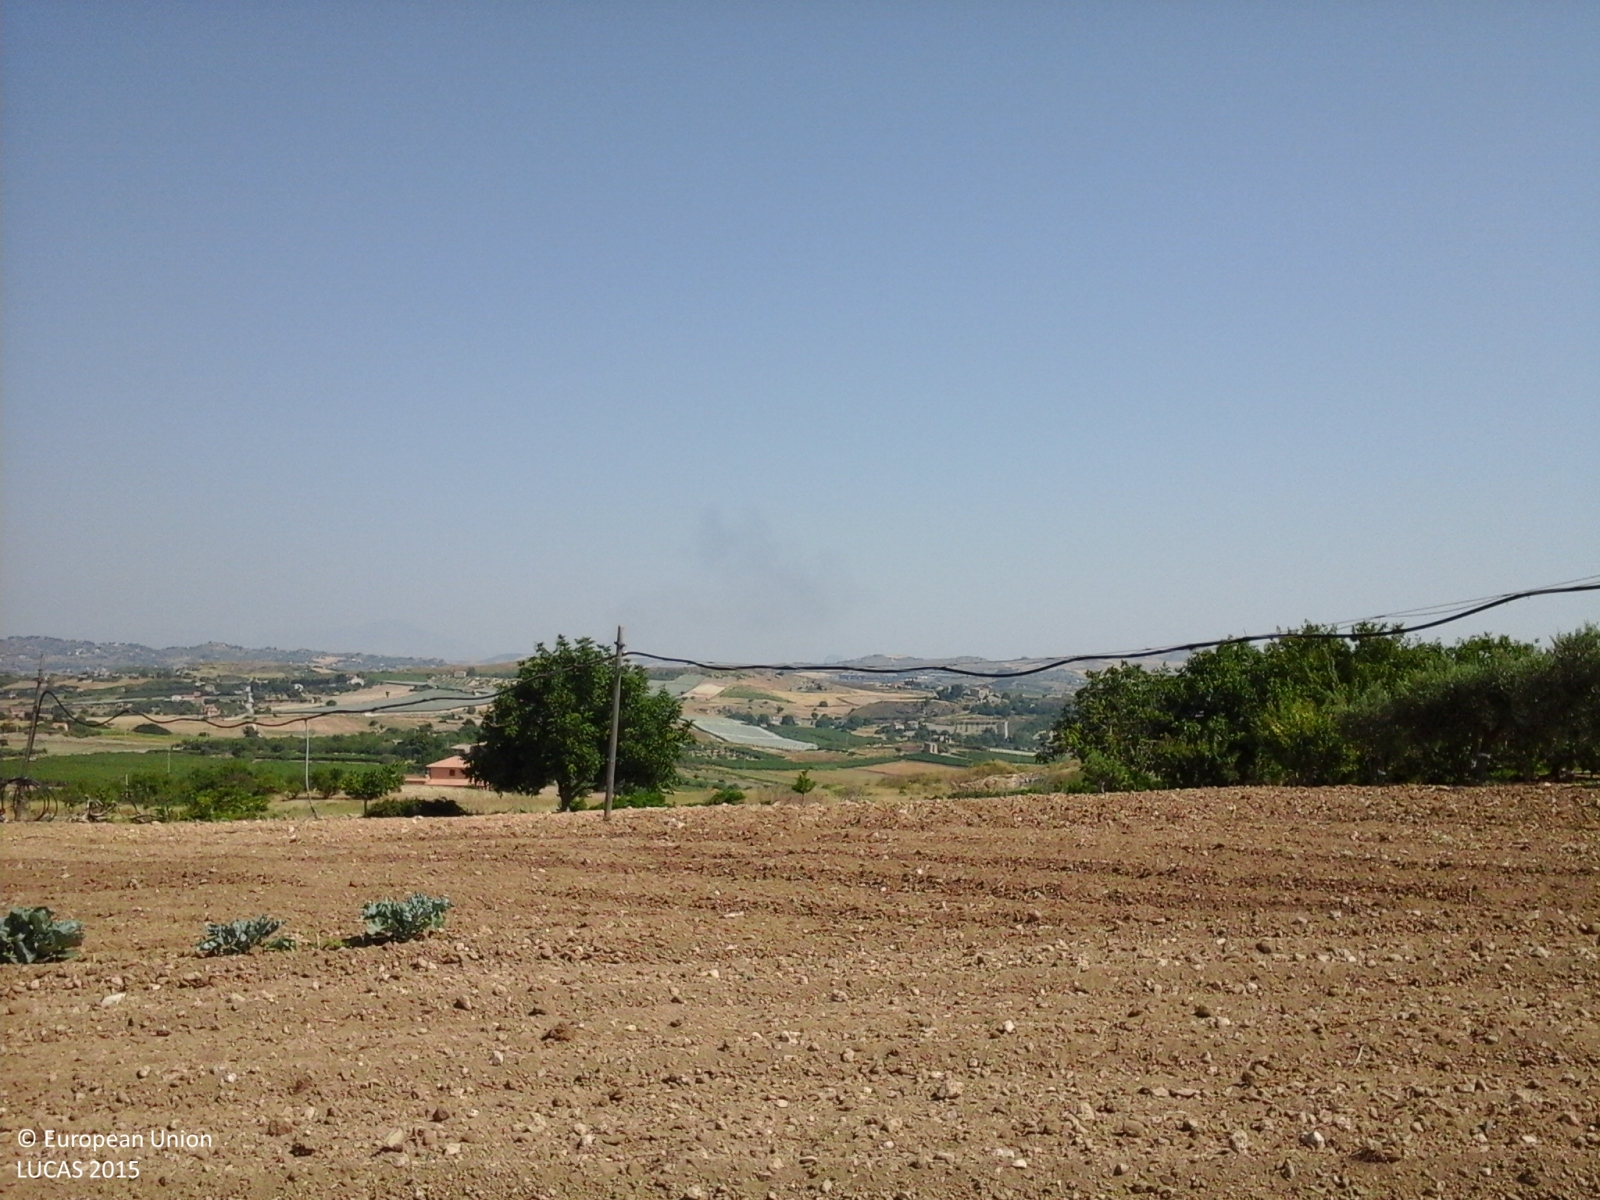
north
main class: Cropland
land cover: Other fresh vegetables
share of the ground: > 75 %
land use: Kitchen garden
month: July
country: IT
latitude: 37.3455
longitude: 13.7750
